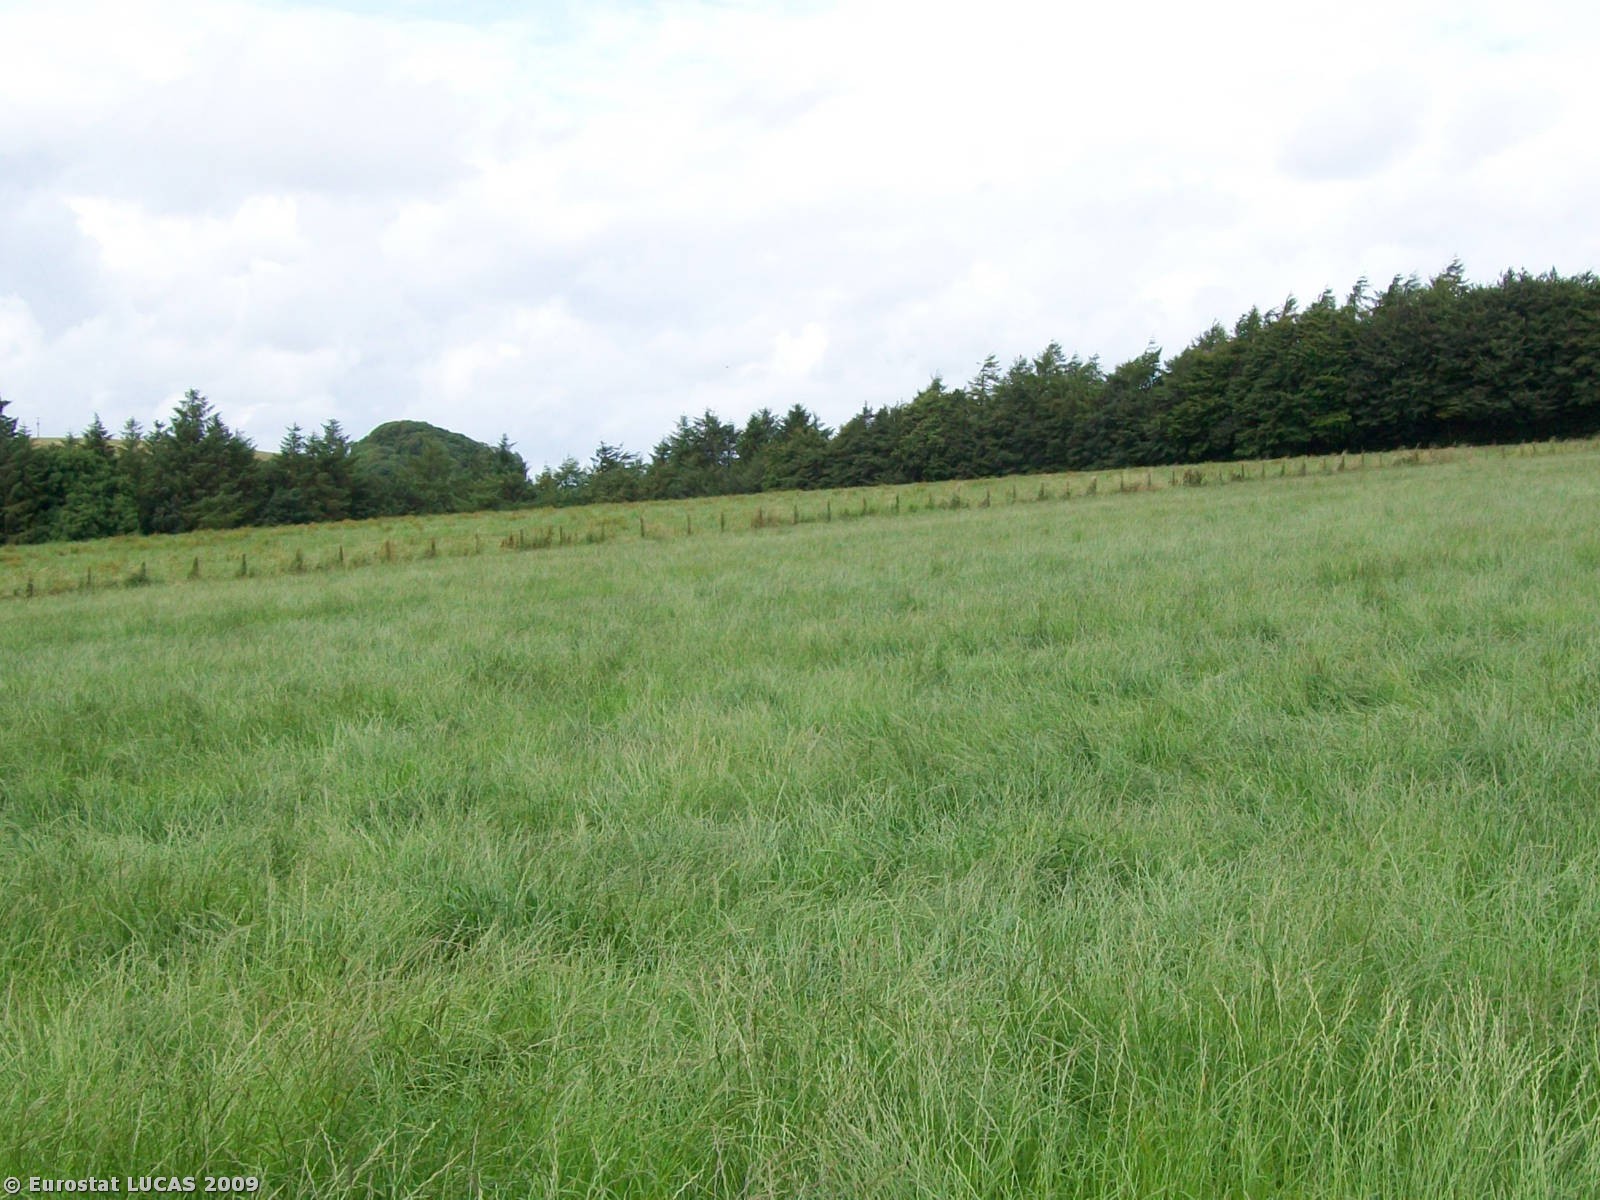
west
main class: Grassland
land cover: Grassland without tree/shrub cover
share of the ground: > 75 %
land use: Agriculture (excluding fallow land and kitchen gardens)
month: July
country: GB
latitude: 55.0705
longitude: -3.3099
